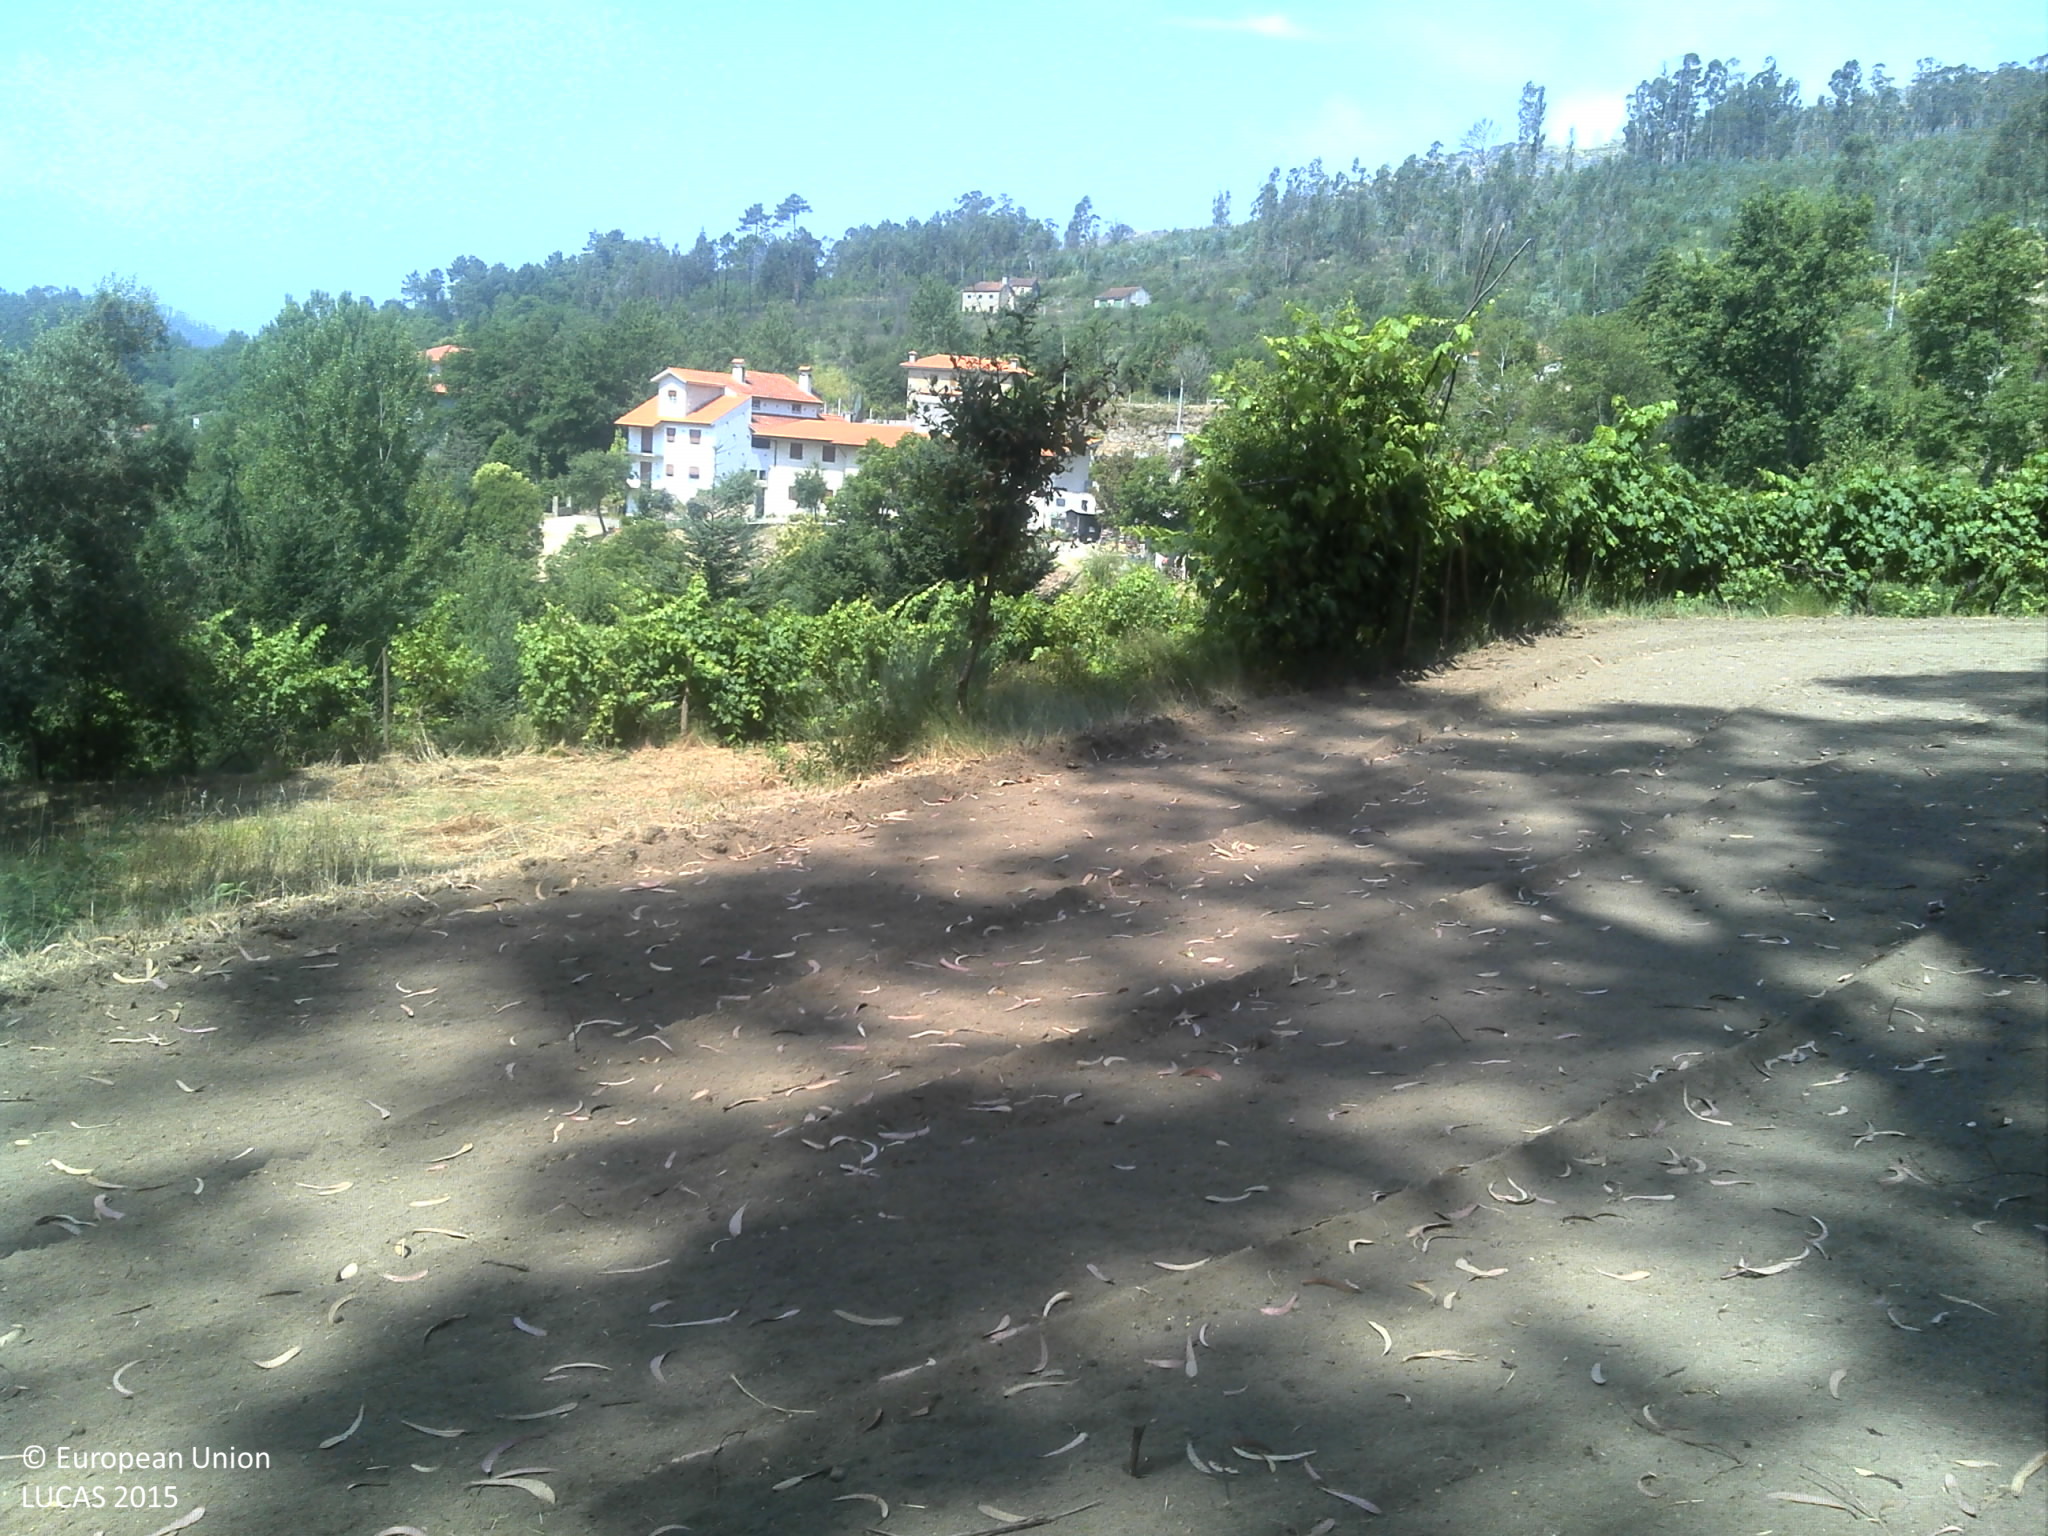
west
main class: Woodland
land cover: Broadleaved woodland
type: exotic forest
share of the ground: > 75 %
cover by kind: broadleaved forest trees 85 %, shrubs 10 %, unconsolidated bare surface 5 %
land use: Forestry
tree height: > 5 m
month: June
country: PT
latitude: 41.1252
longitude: -8.1605
